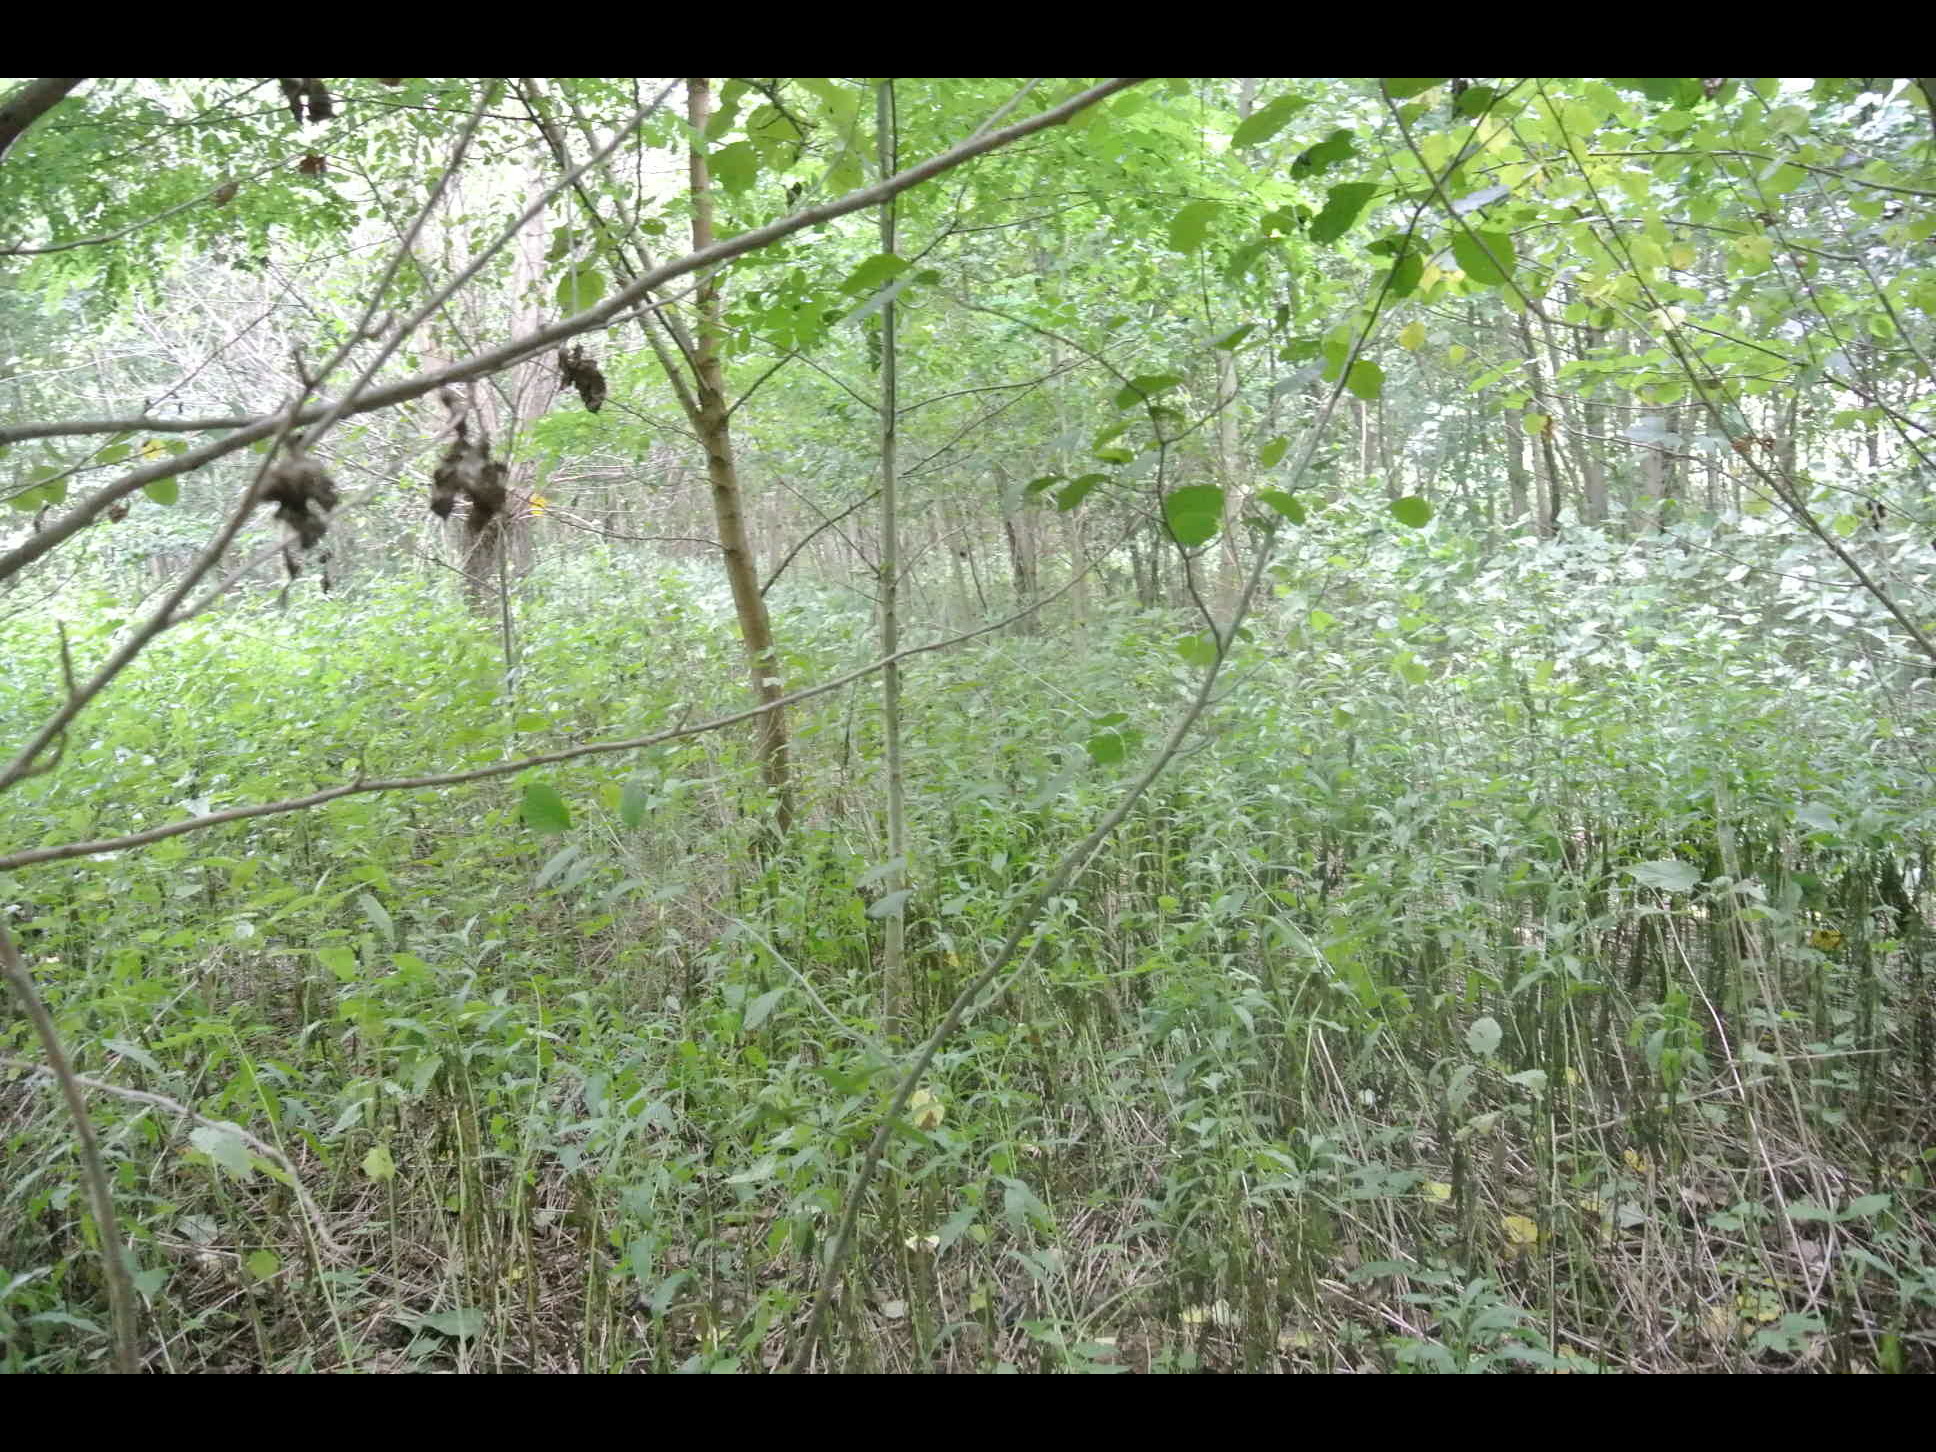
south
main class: Woodland
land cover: Broadleaved woodland
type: floodplain forest
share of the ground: > 75 %
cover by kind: broadleaved forest trees 100 %
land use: Forestry
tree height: > 5 m
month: July
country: AT
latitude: 47.4677
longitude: 16.5712
